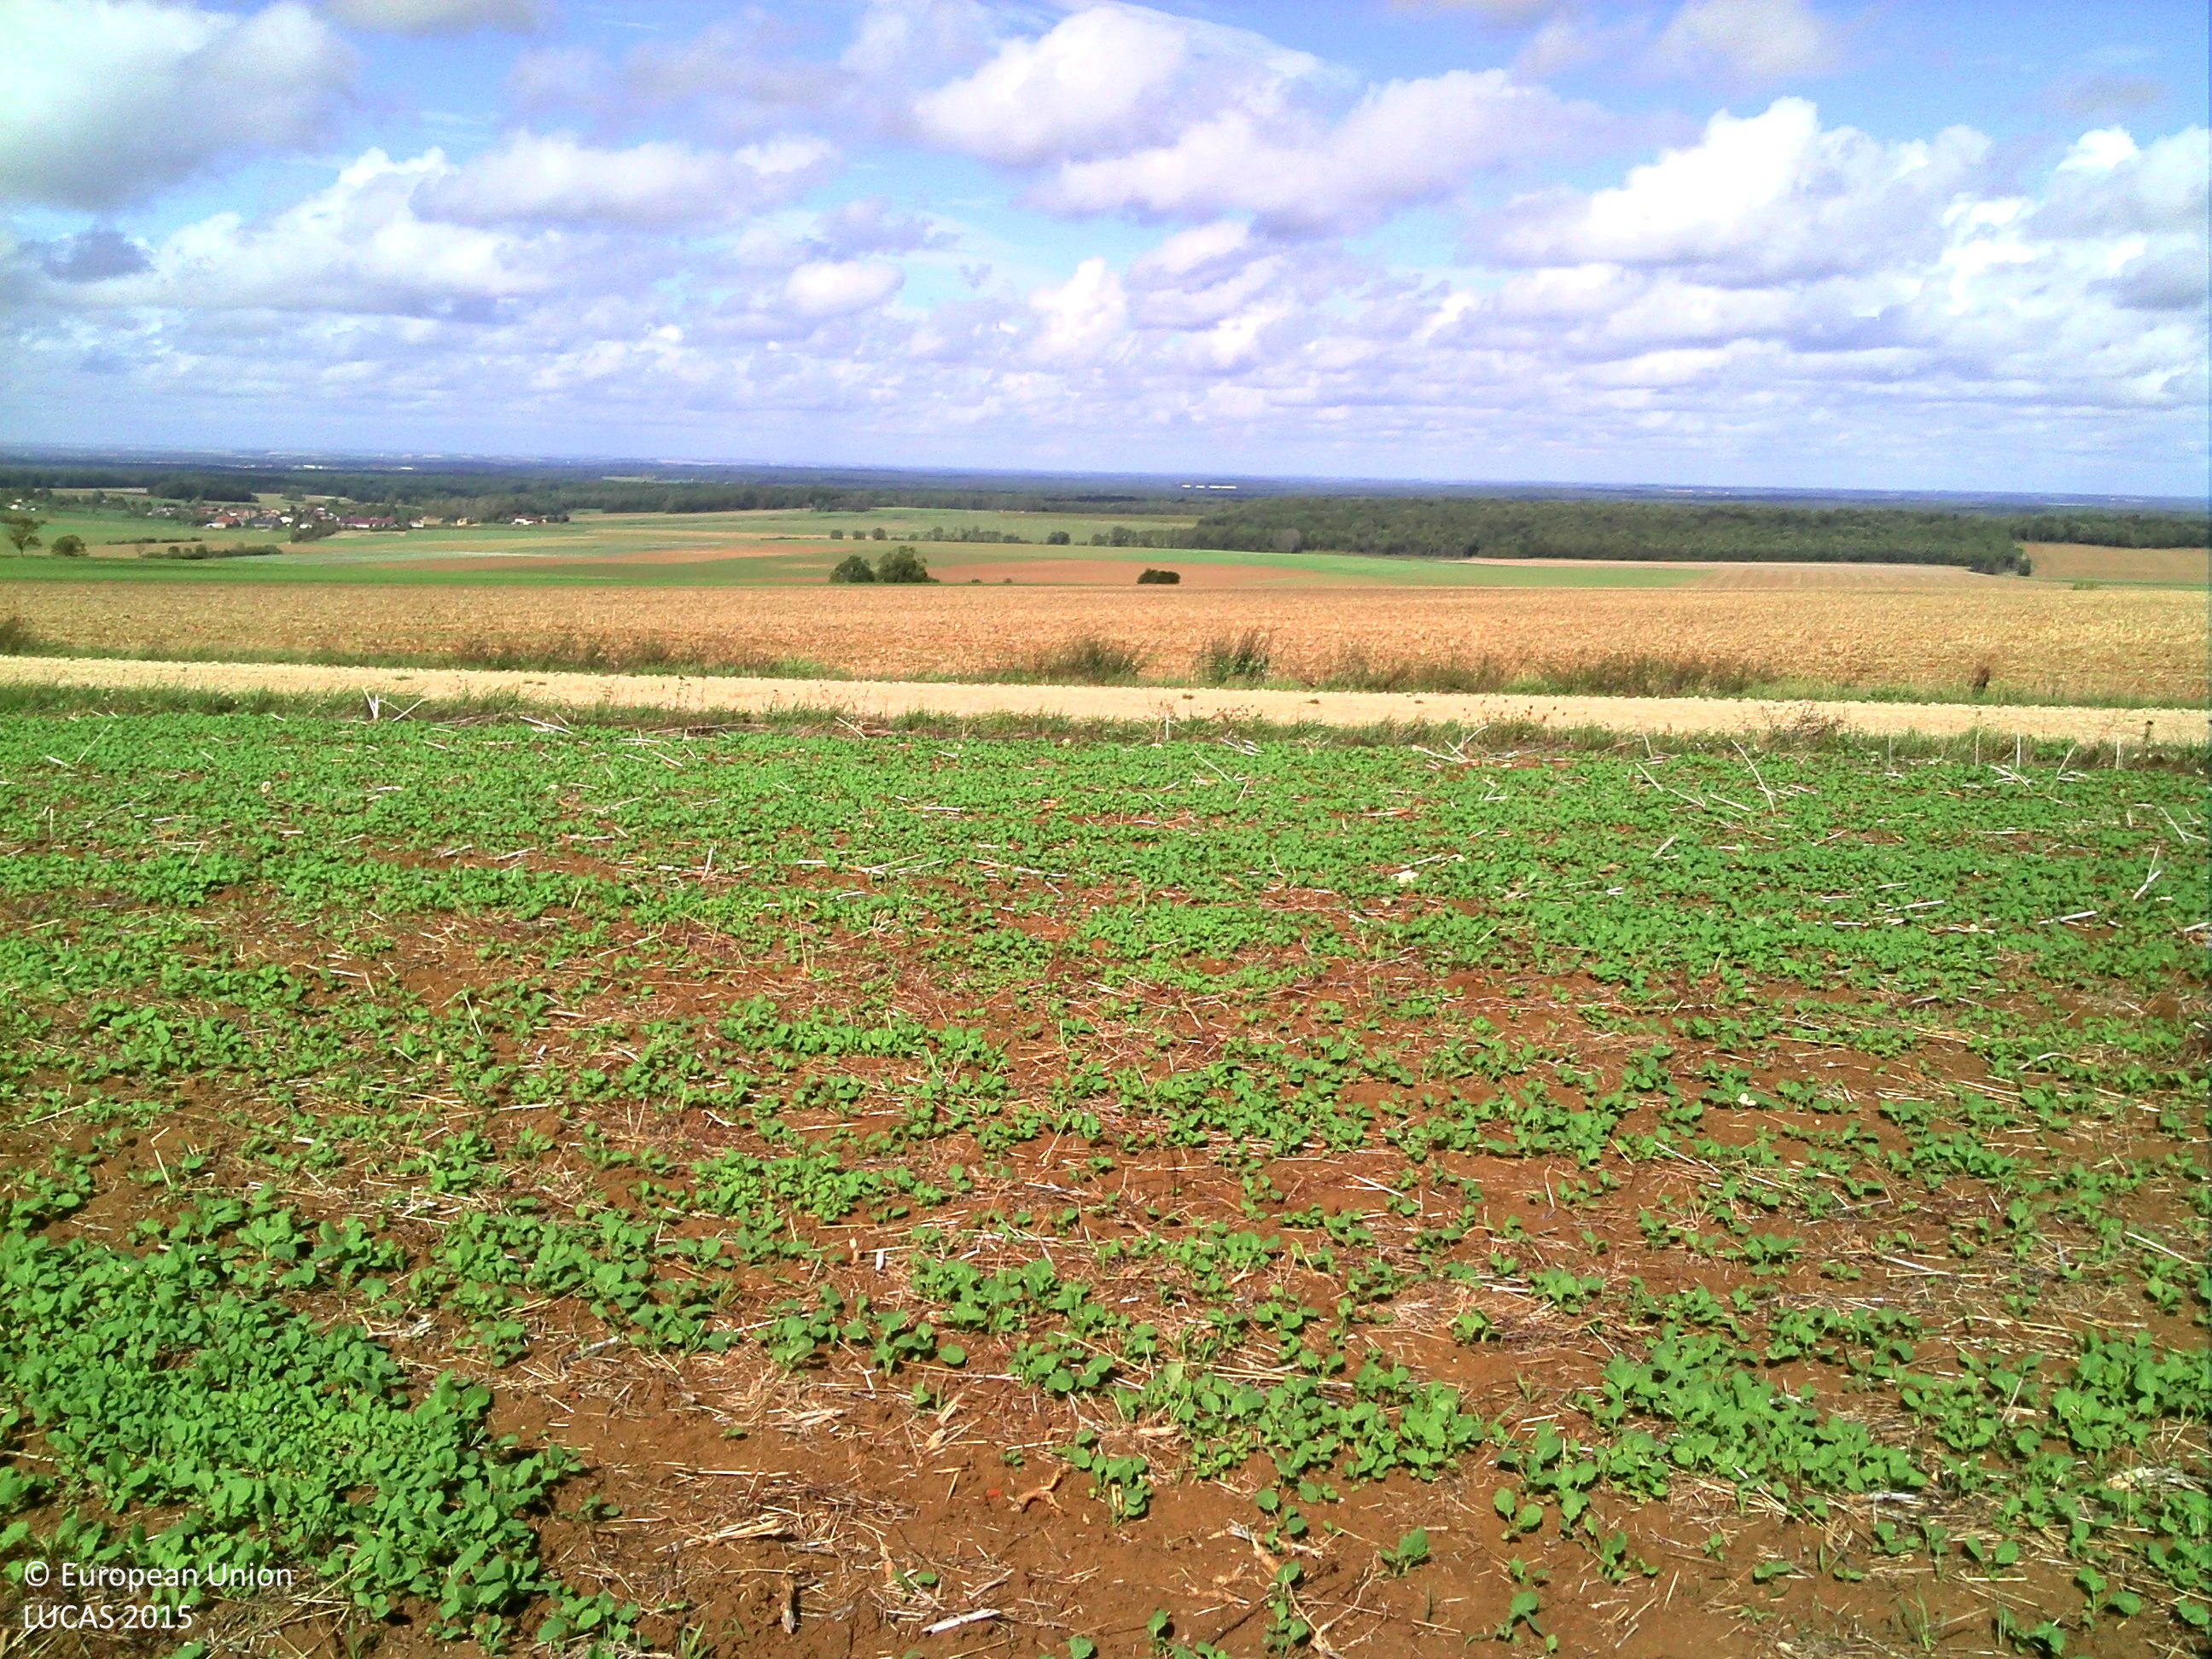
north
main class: Cropland
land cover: Rape and turnip rape
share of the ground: 10 - 25 %
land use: Agriculture (excluding fallow land and kitchen gardens)
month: September
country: FR
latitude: 48.2945
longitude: 4.7007
